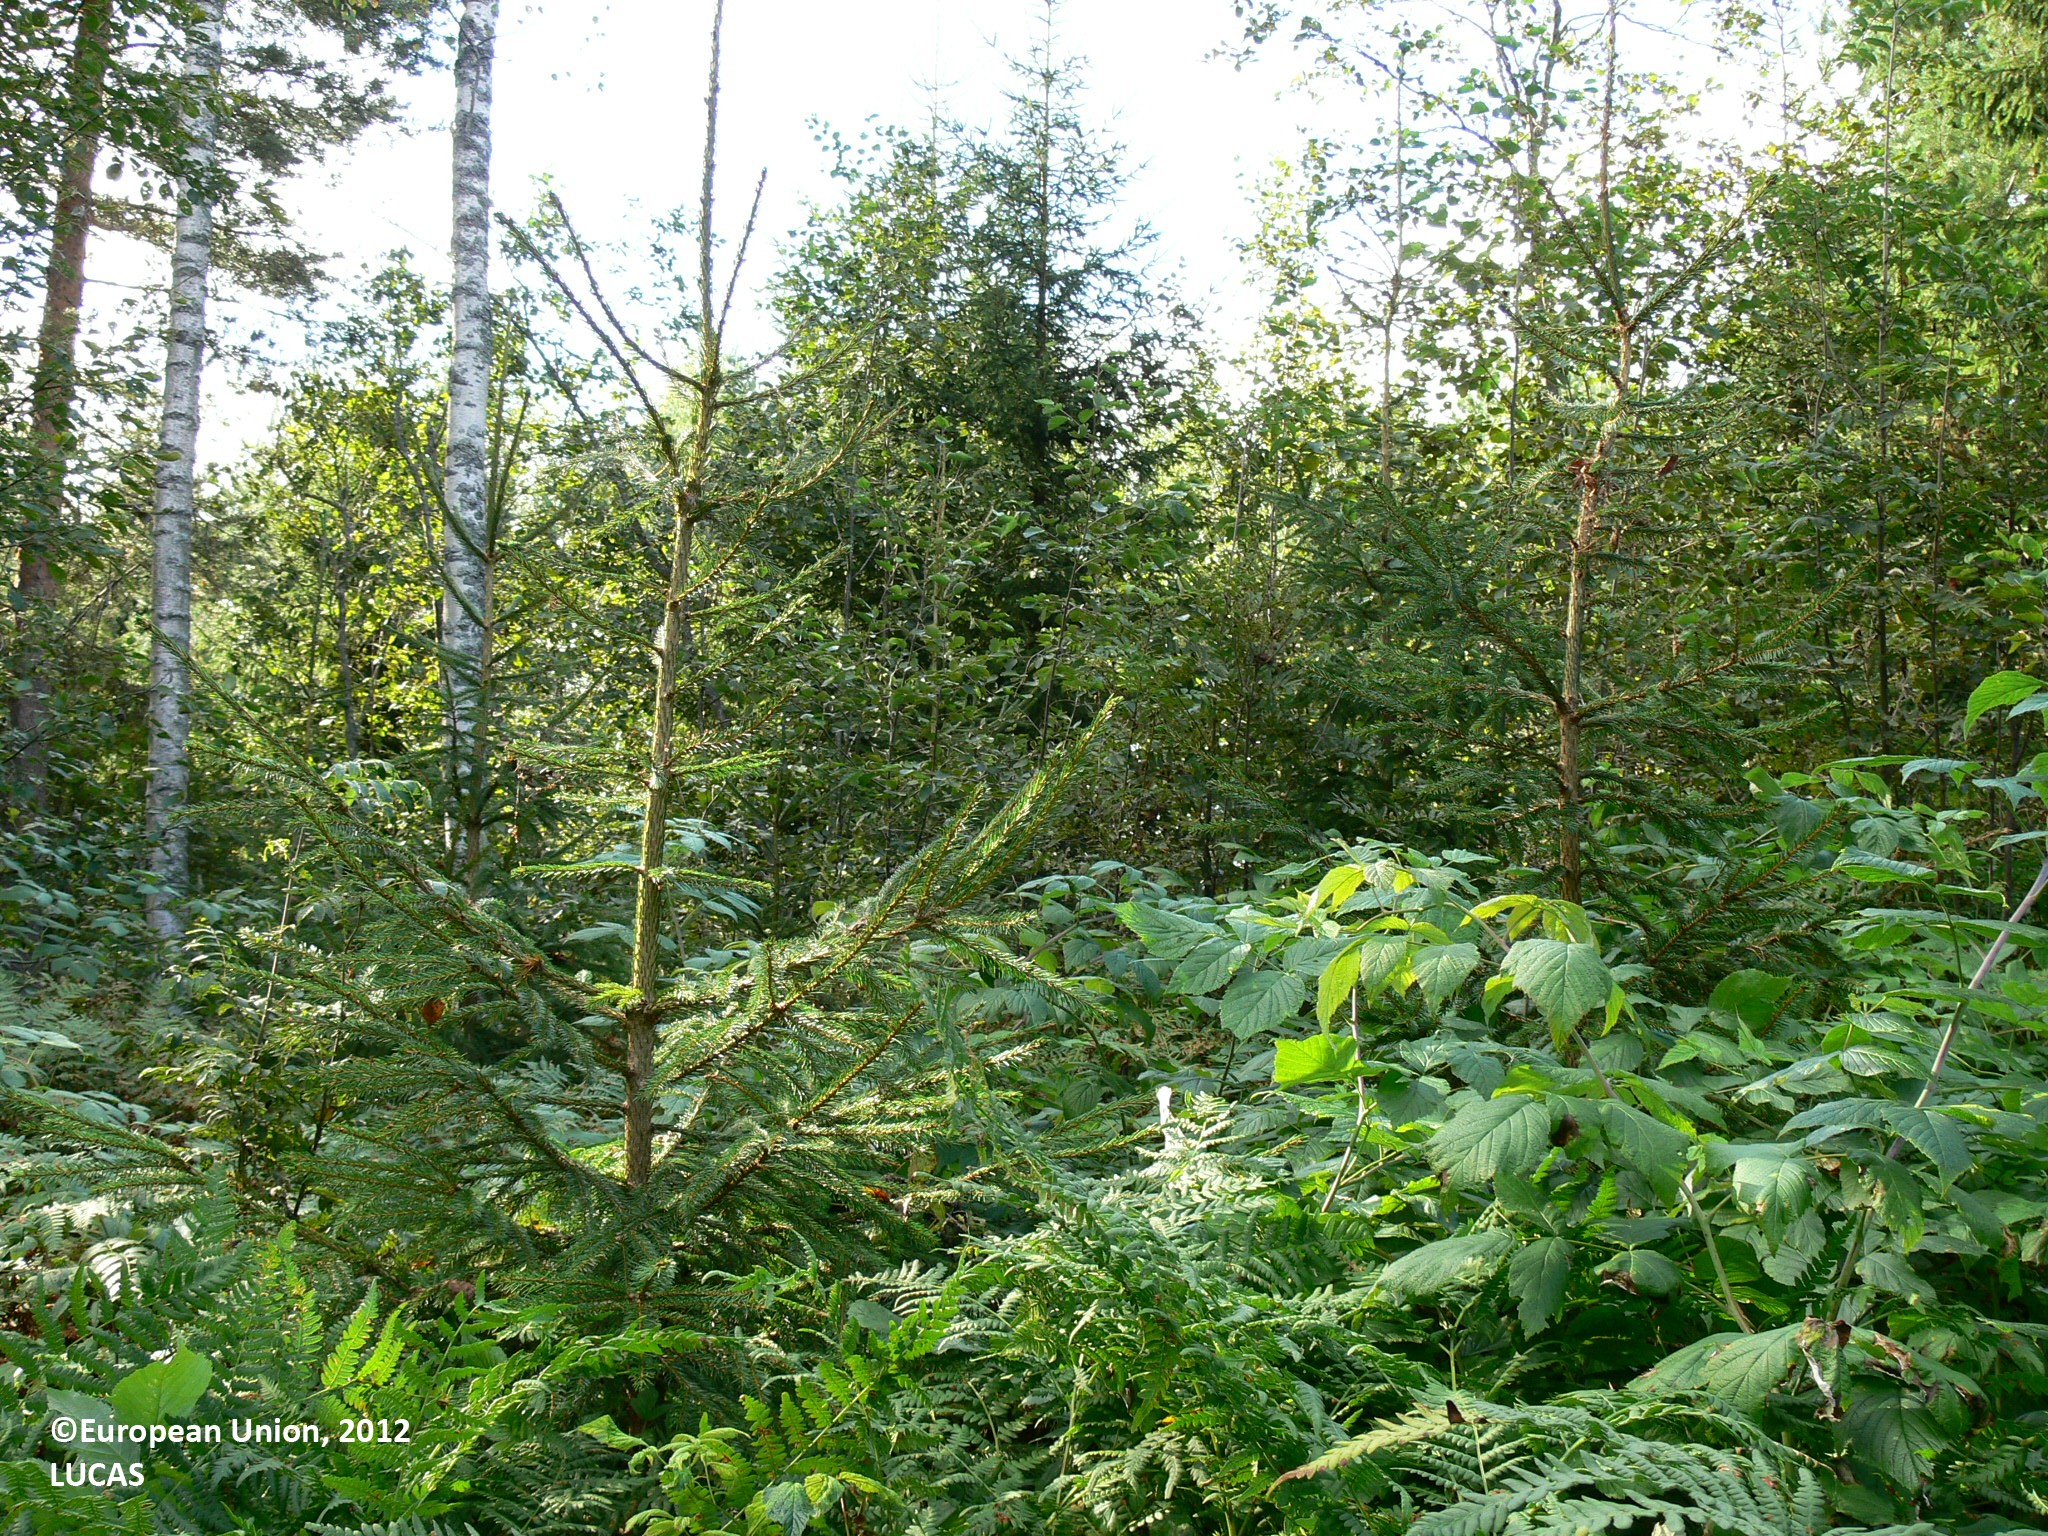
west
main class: Woodland
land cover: Spruce dominated coniferous woodland
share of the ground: 10 - 25 %
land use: Forestry
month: August
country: FI
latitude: 62.0469
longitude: 30.3008
